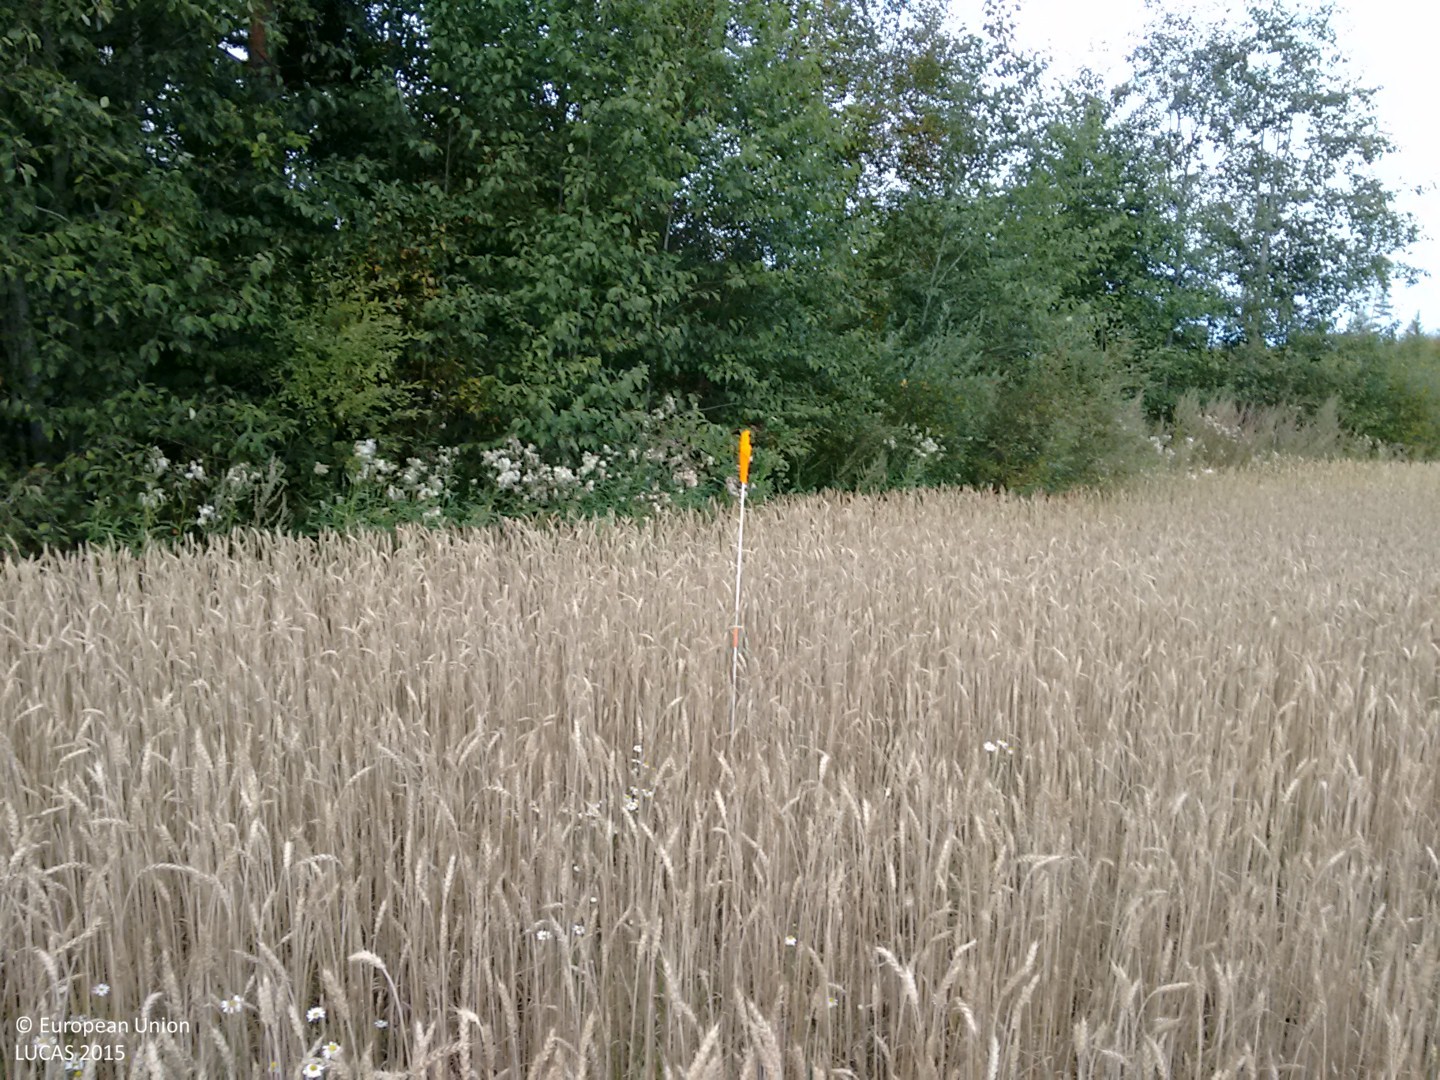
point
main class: Cropland
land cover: Common wheat
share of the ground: > 75 %
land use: Agriculture (excluding fallow land and kitchen gardens)
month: September
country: FI
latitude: 60.8754
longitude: 21.9401
